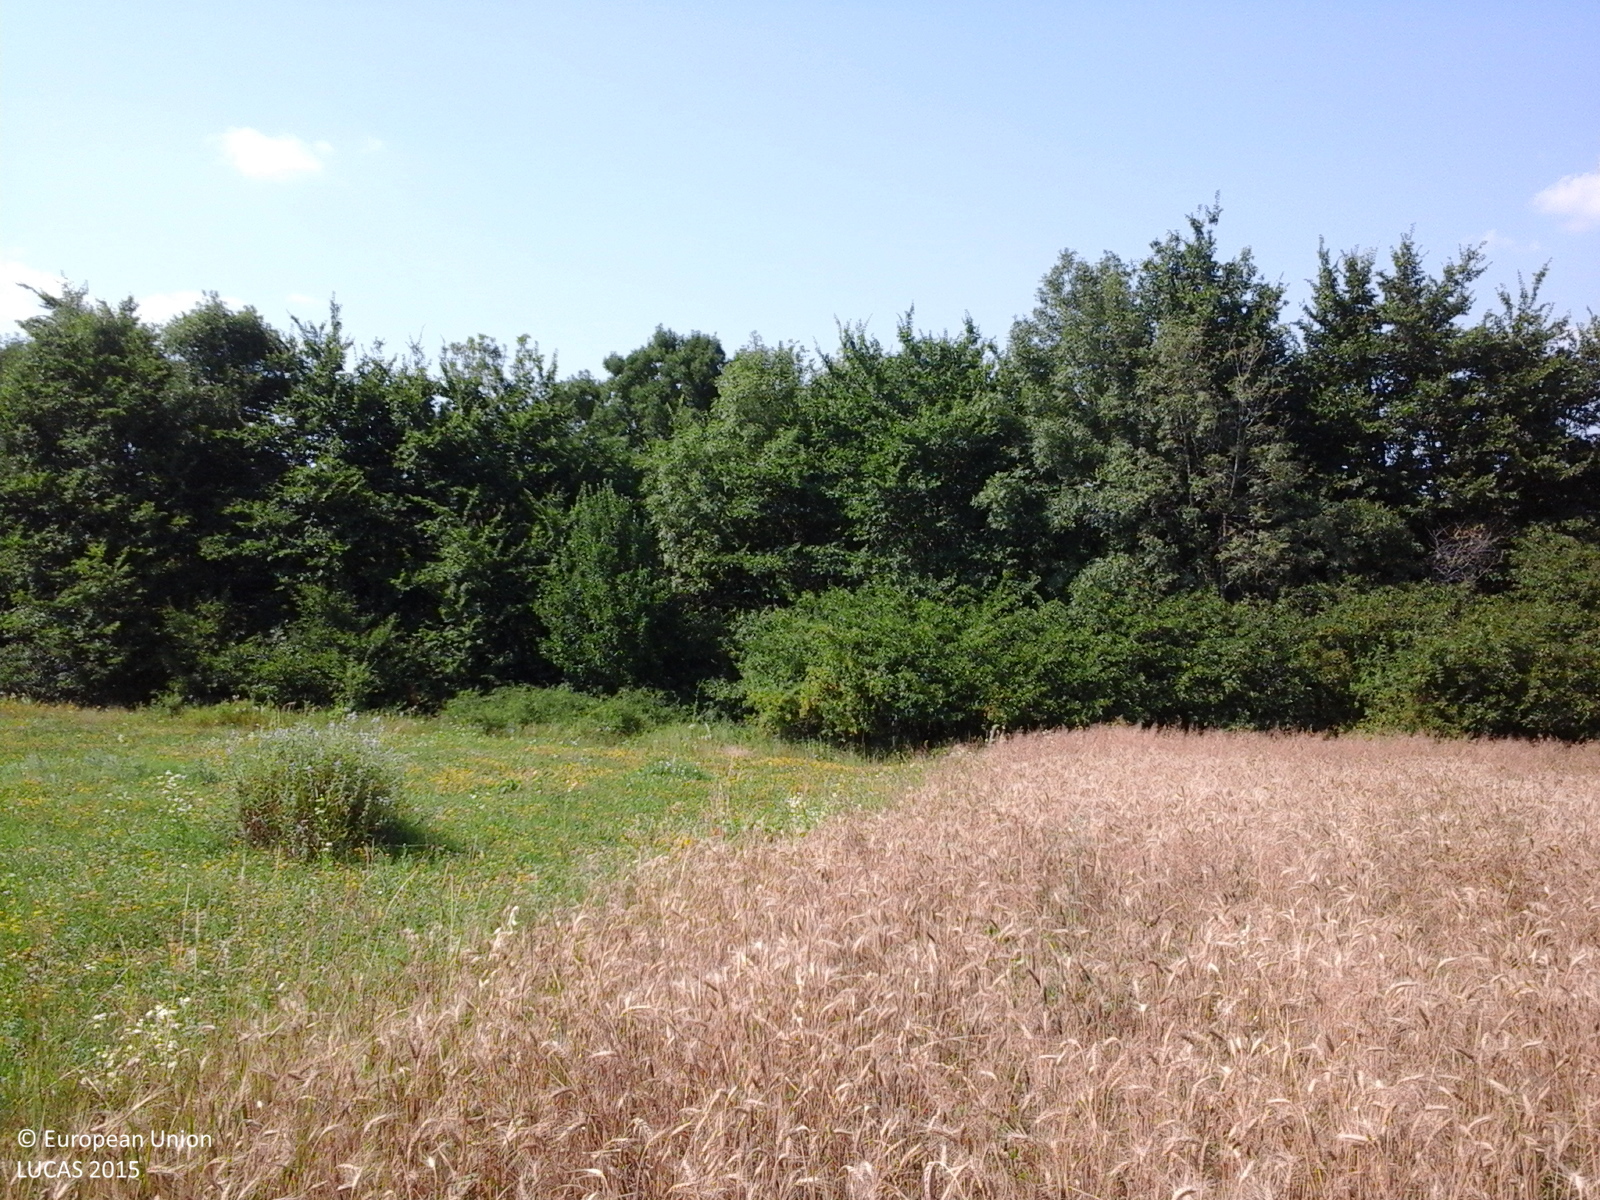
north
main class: Cropland
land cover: Common wheat
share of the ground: > 75 %
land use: Agriculture (excluding fallow land and kitchen gardens)
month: July
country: RO
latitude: 44.7164
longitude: 24.6307
